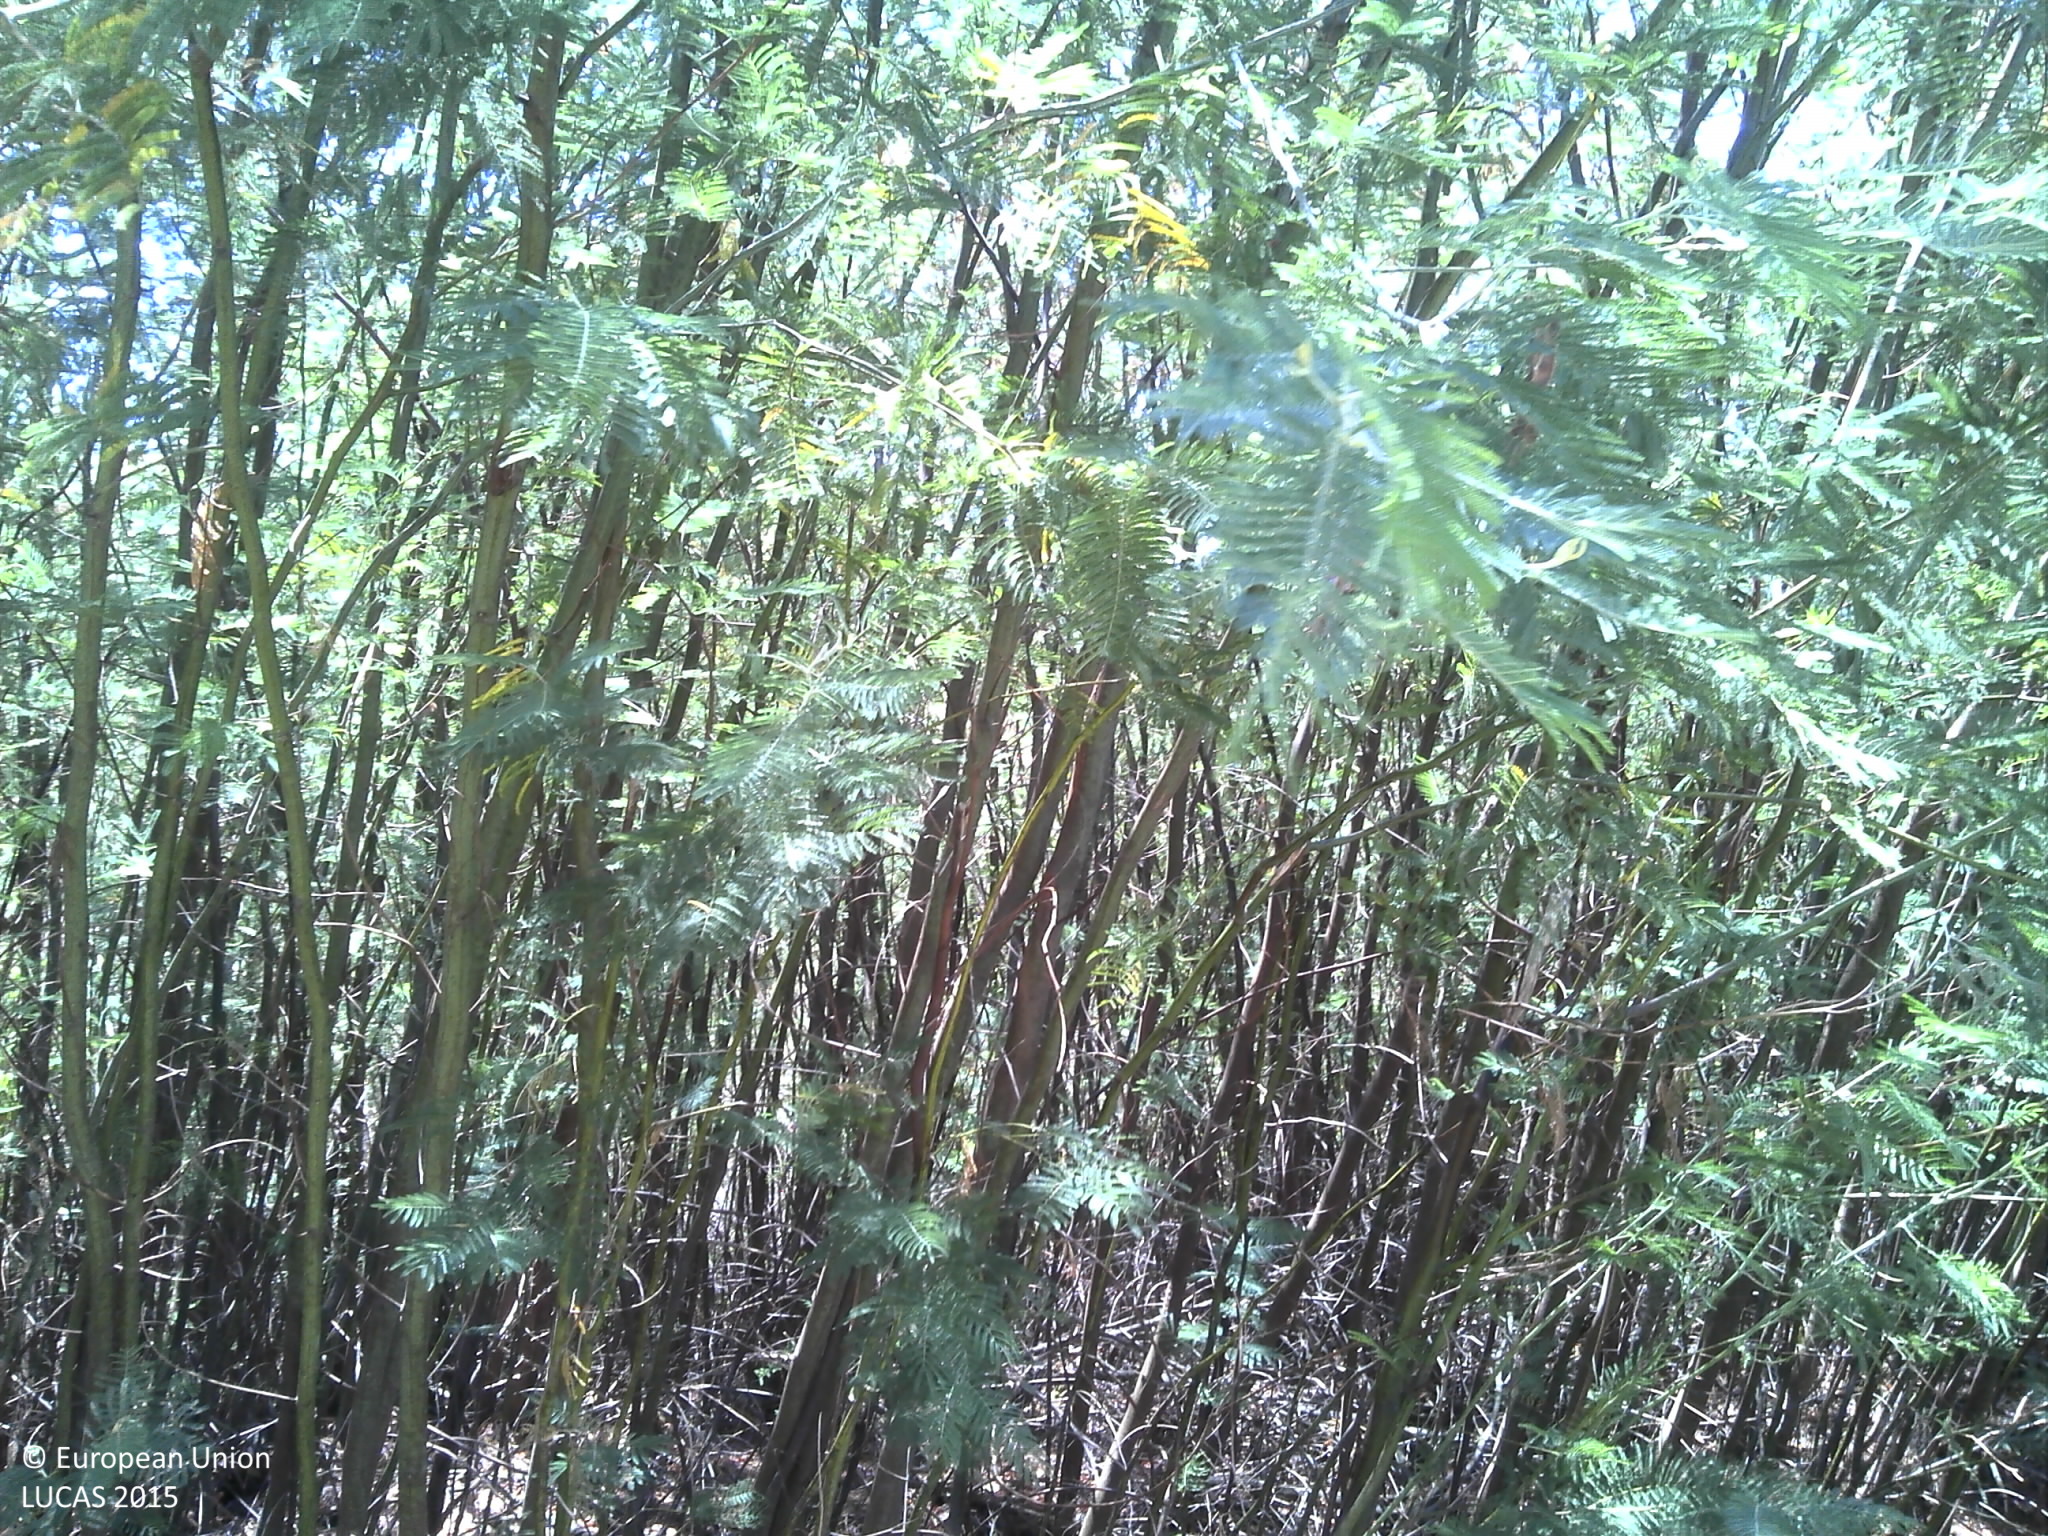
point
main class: Woodland
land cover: Broadleaved woodland
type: exotic forest
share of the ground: > 75 %
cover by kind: broadleaved forest trees 80 %, shrubs 20 %
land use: Abandoned areas
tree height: > 5 m
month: July
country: PT
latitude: 40.2451
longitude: -7.9270
